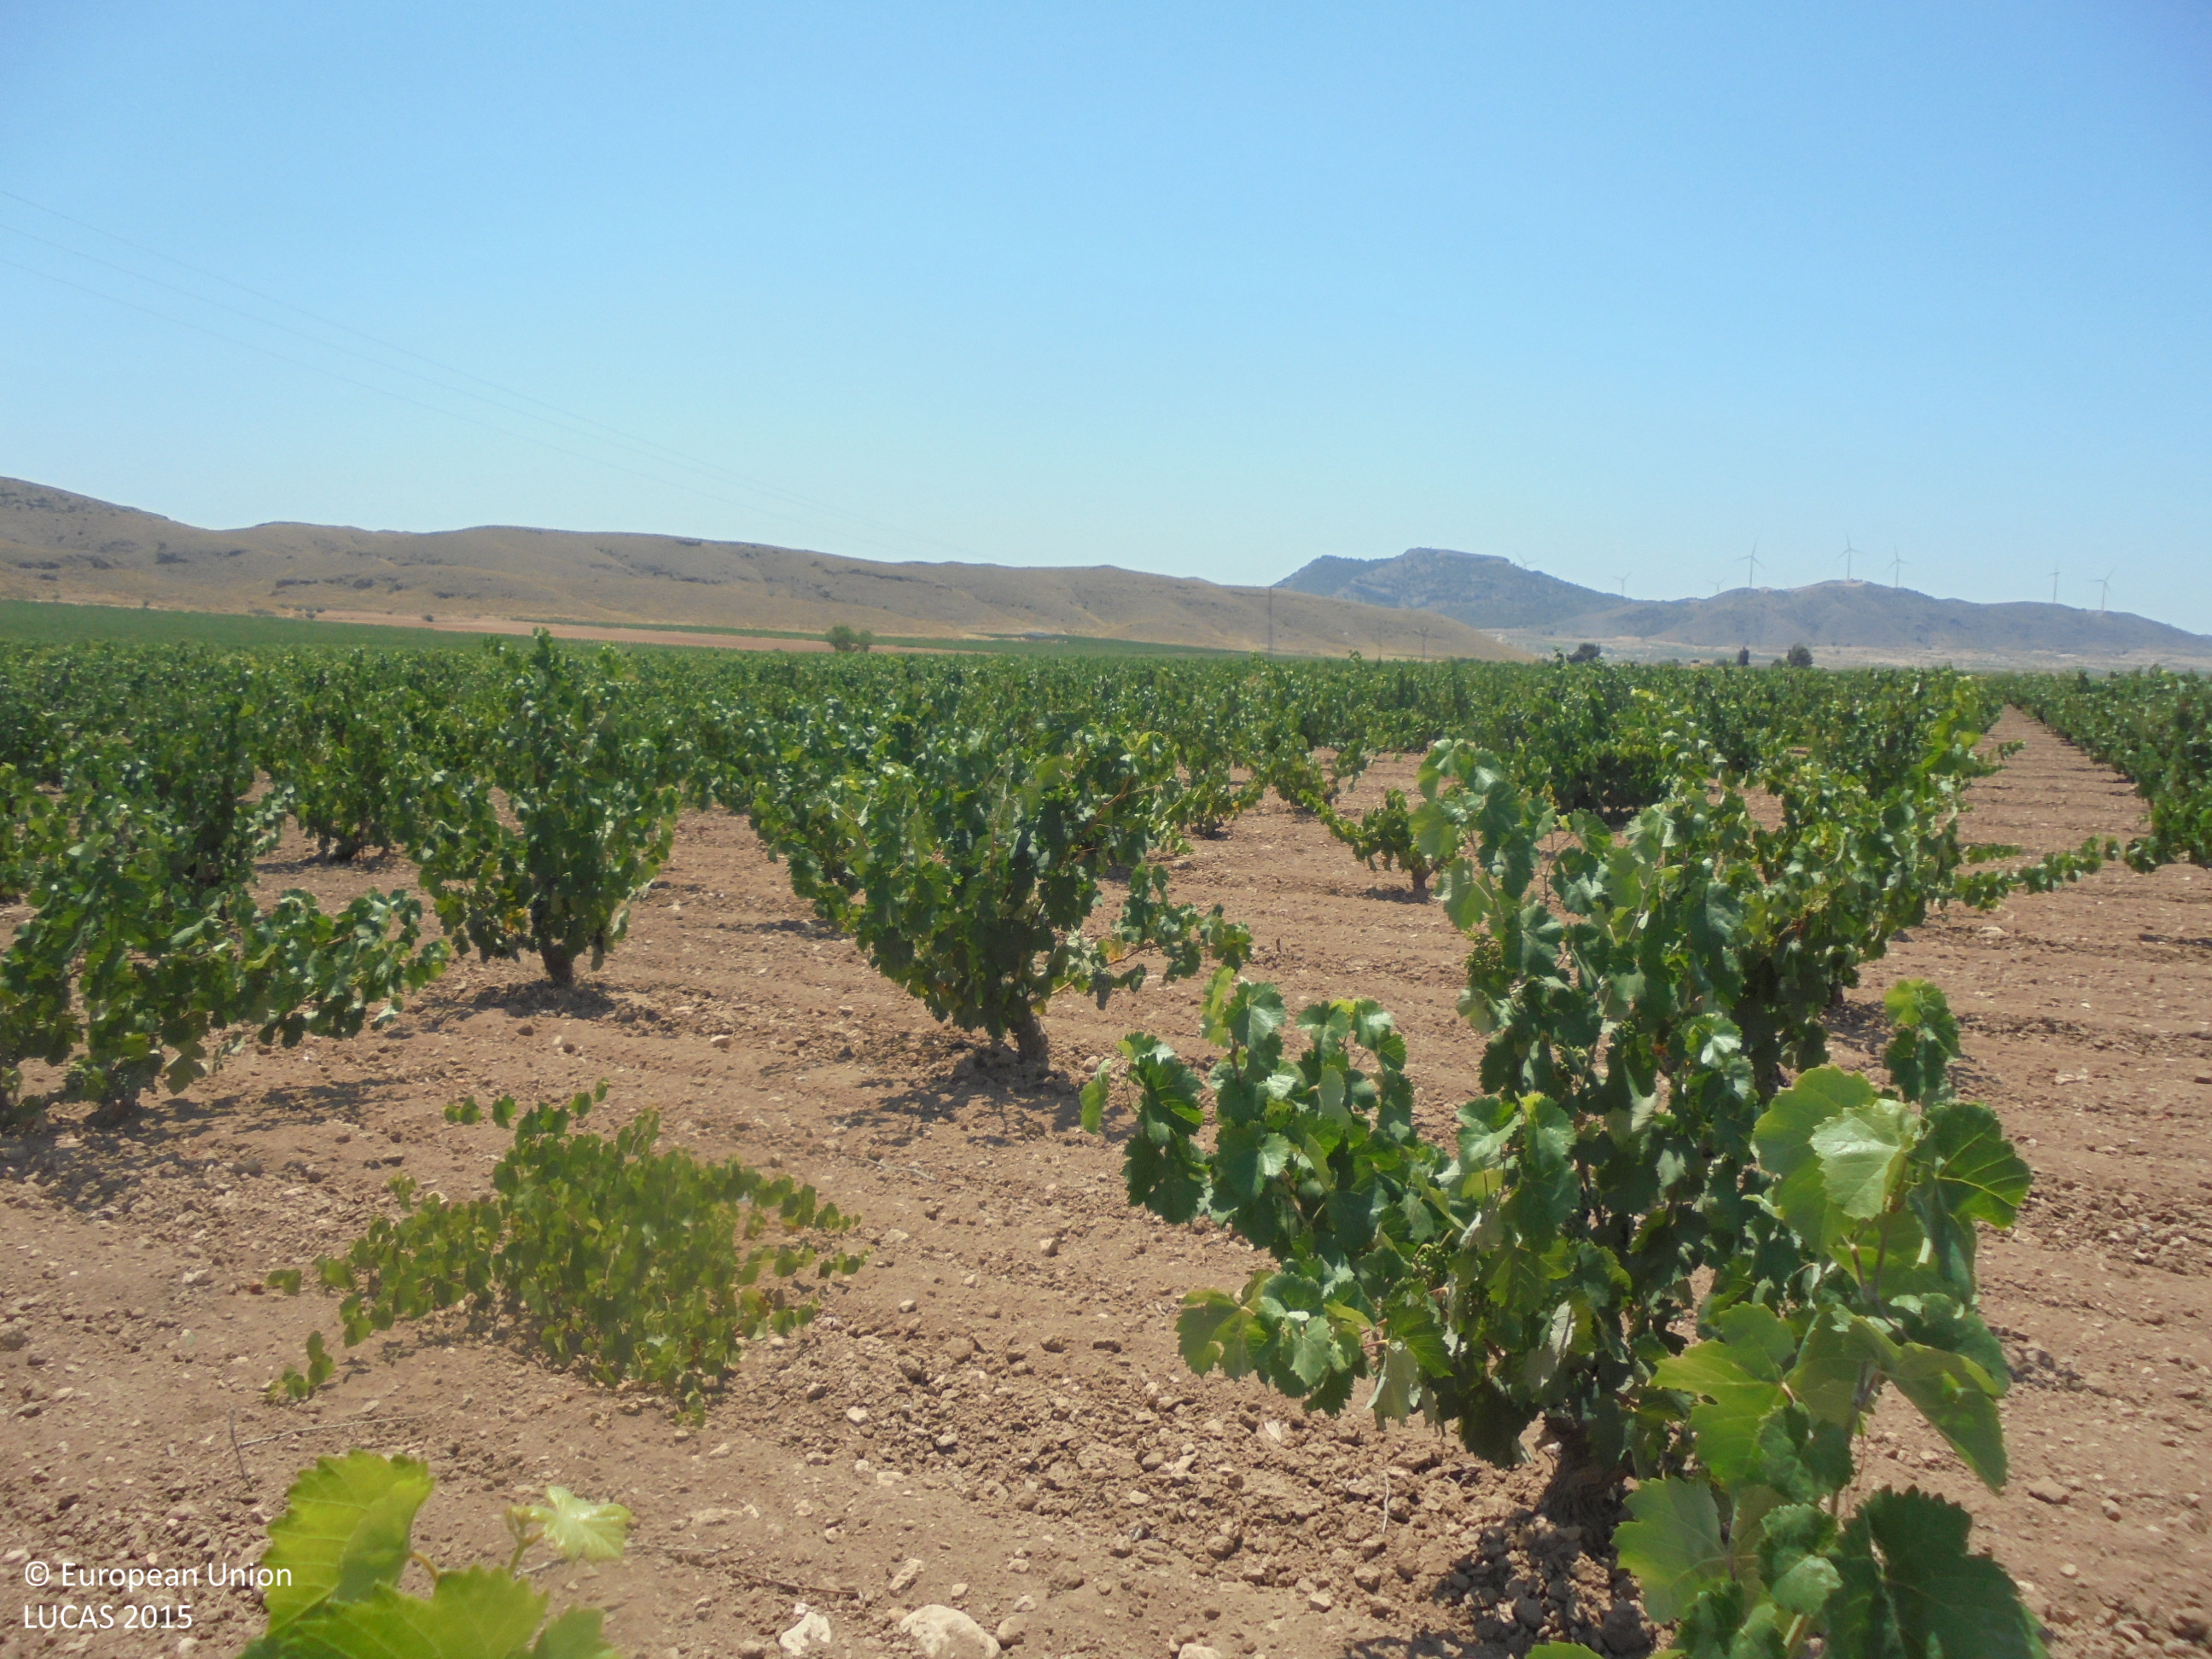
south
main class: Cropland
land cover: Vineyards
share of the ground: 25 - 50 %
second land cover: Other bare soil
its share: > 75 %
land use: Agriculture (excluding fallow land and kitchen gardens)
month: July
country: ES
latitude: 38.5429
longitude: -1.3848
